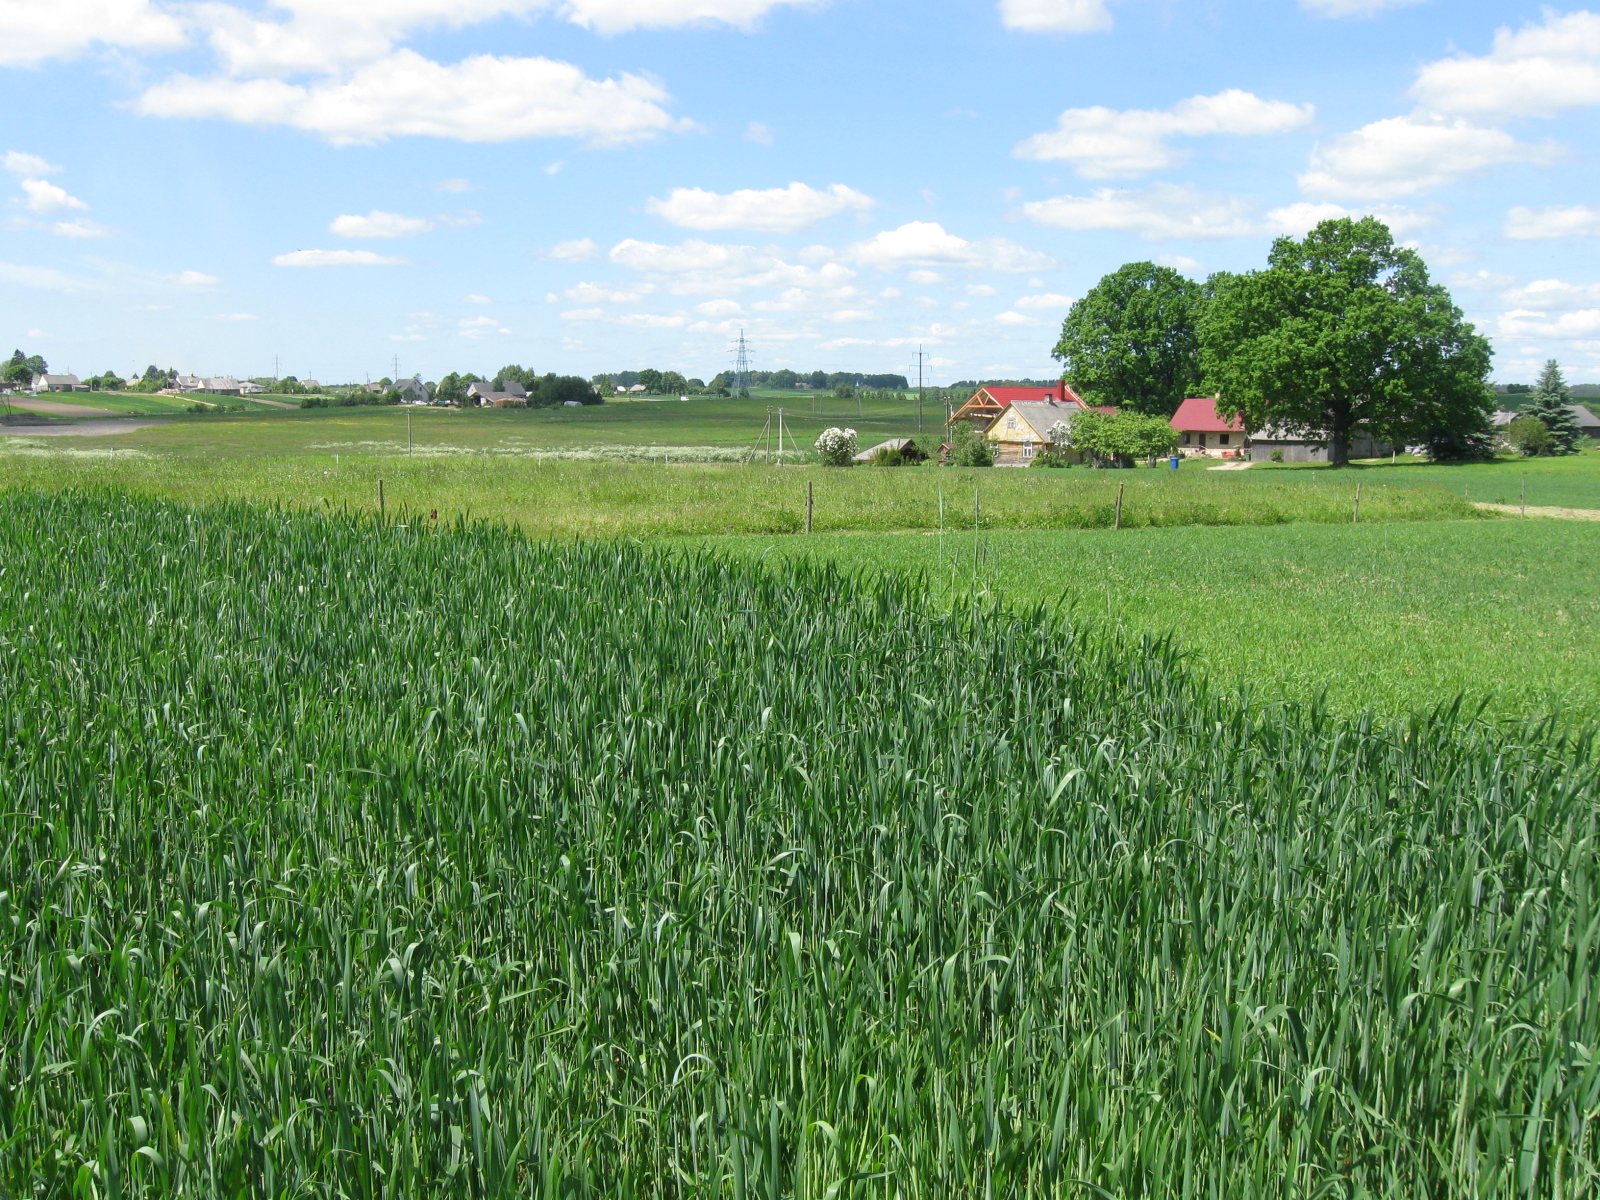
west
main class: Cropland
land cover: Common wheat
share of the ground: > 75 %
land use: Agriculture (excluding fallow land and kitchen gardens)
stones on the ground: < 10 %
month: June
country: LT
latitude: 54.5916
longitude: 23.8469
